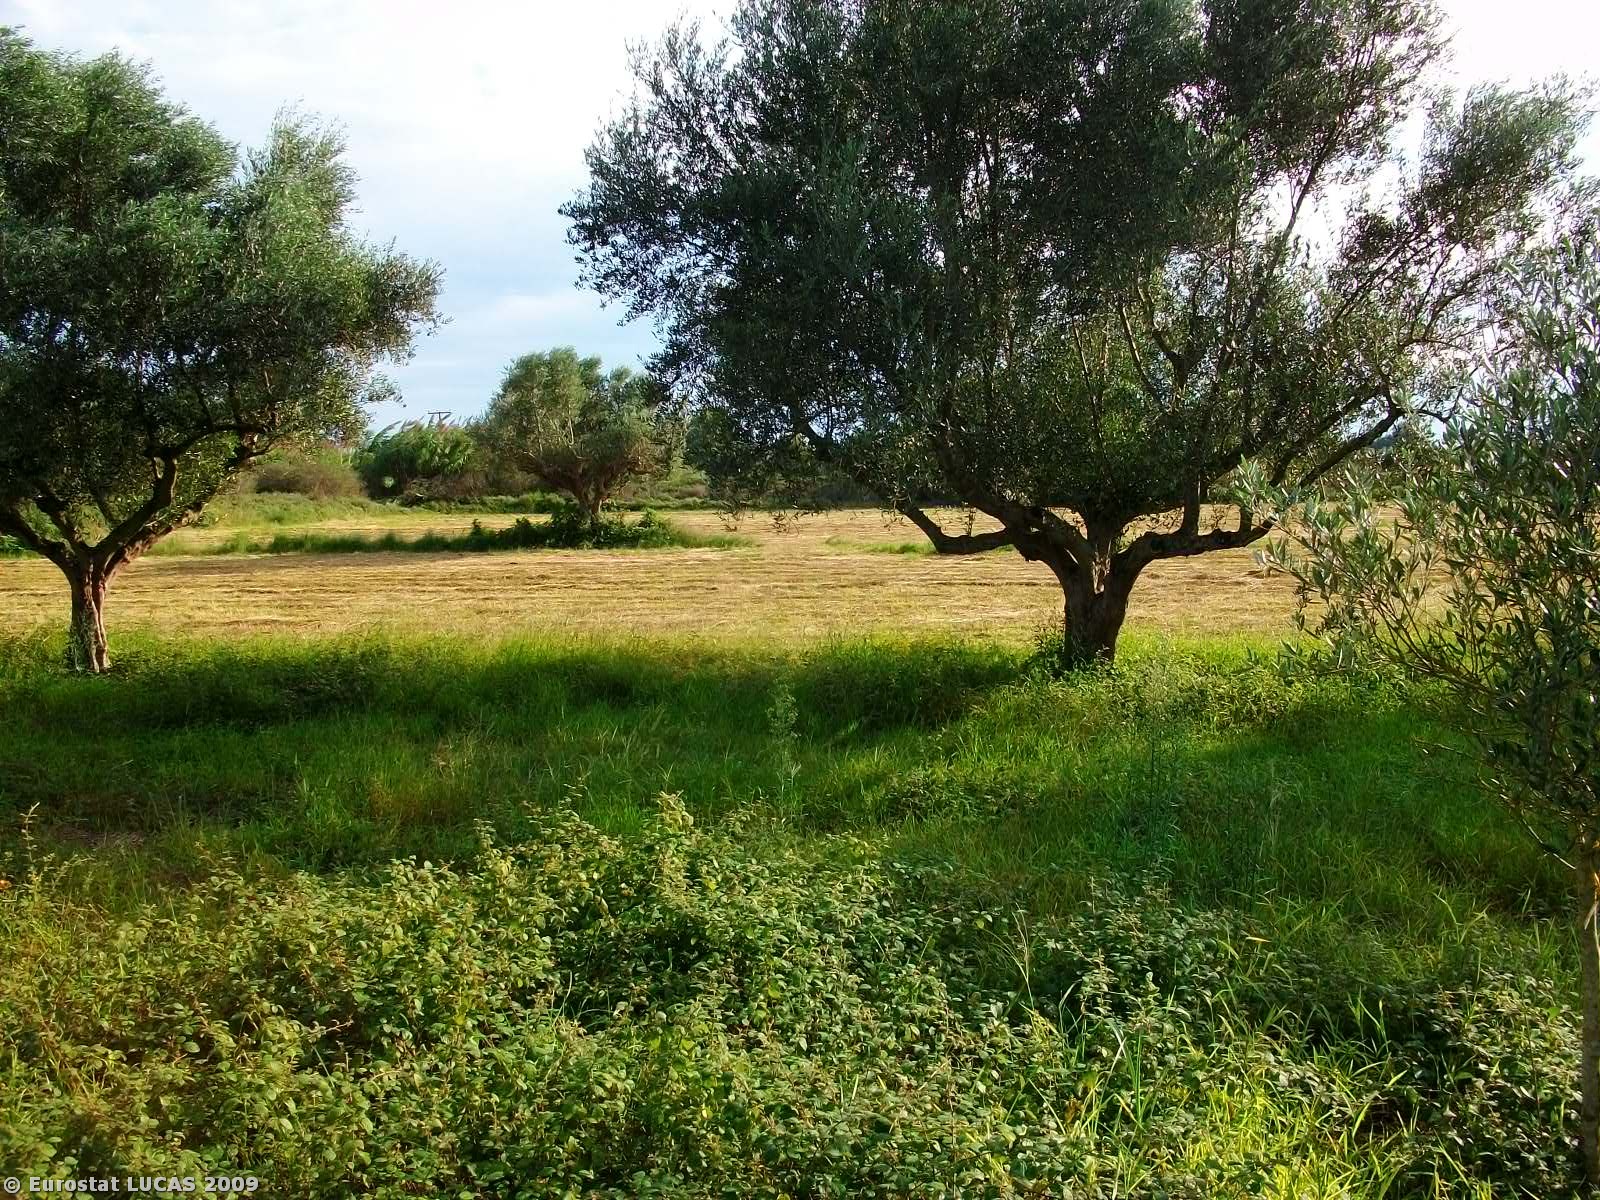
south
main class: Cropland
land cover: Olive groves
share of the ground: 10 - 25 %
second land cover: Grassland with sparse tree/shrub cover
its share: > 75 %
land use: Agriculture (excluding fallow land and kitchen gardens)
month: September
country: GR
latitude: 37.6898
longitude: 21.3327
